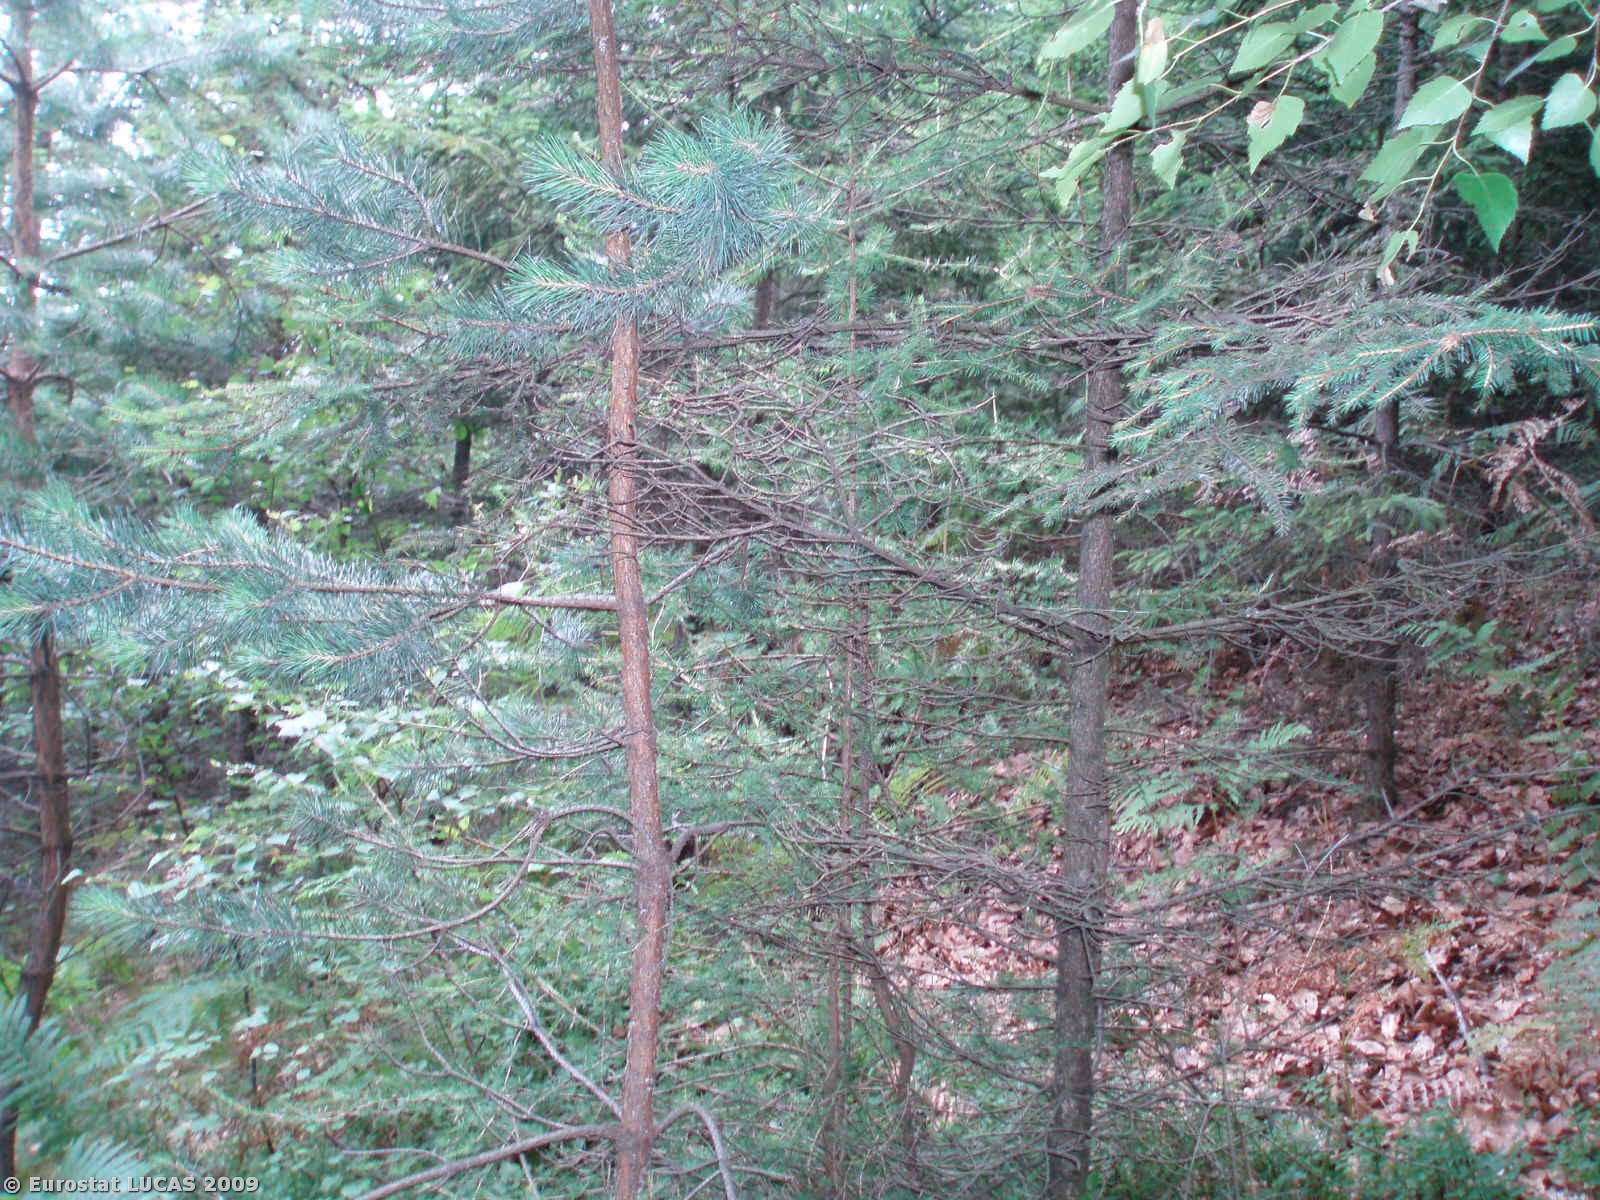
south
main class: Woodland
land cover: Mixed woodland
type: beech forest
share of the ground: > 75 %
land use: Forestry
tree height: > 5 m
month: July
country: CZ
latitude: 50.7906
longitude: 14.2145
